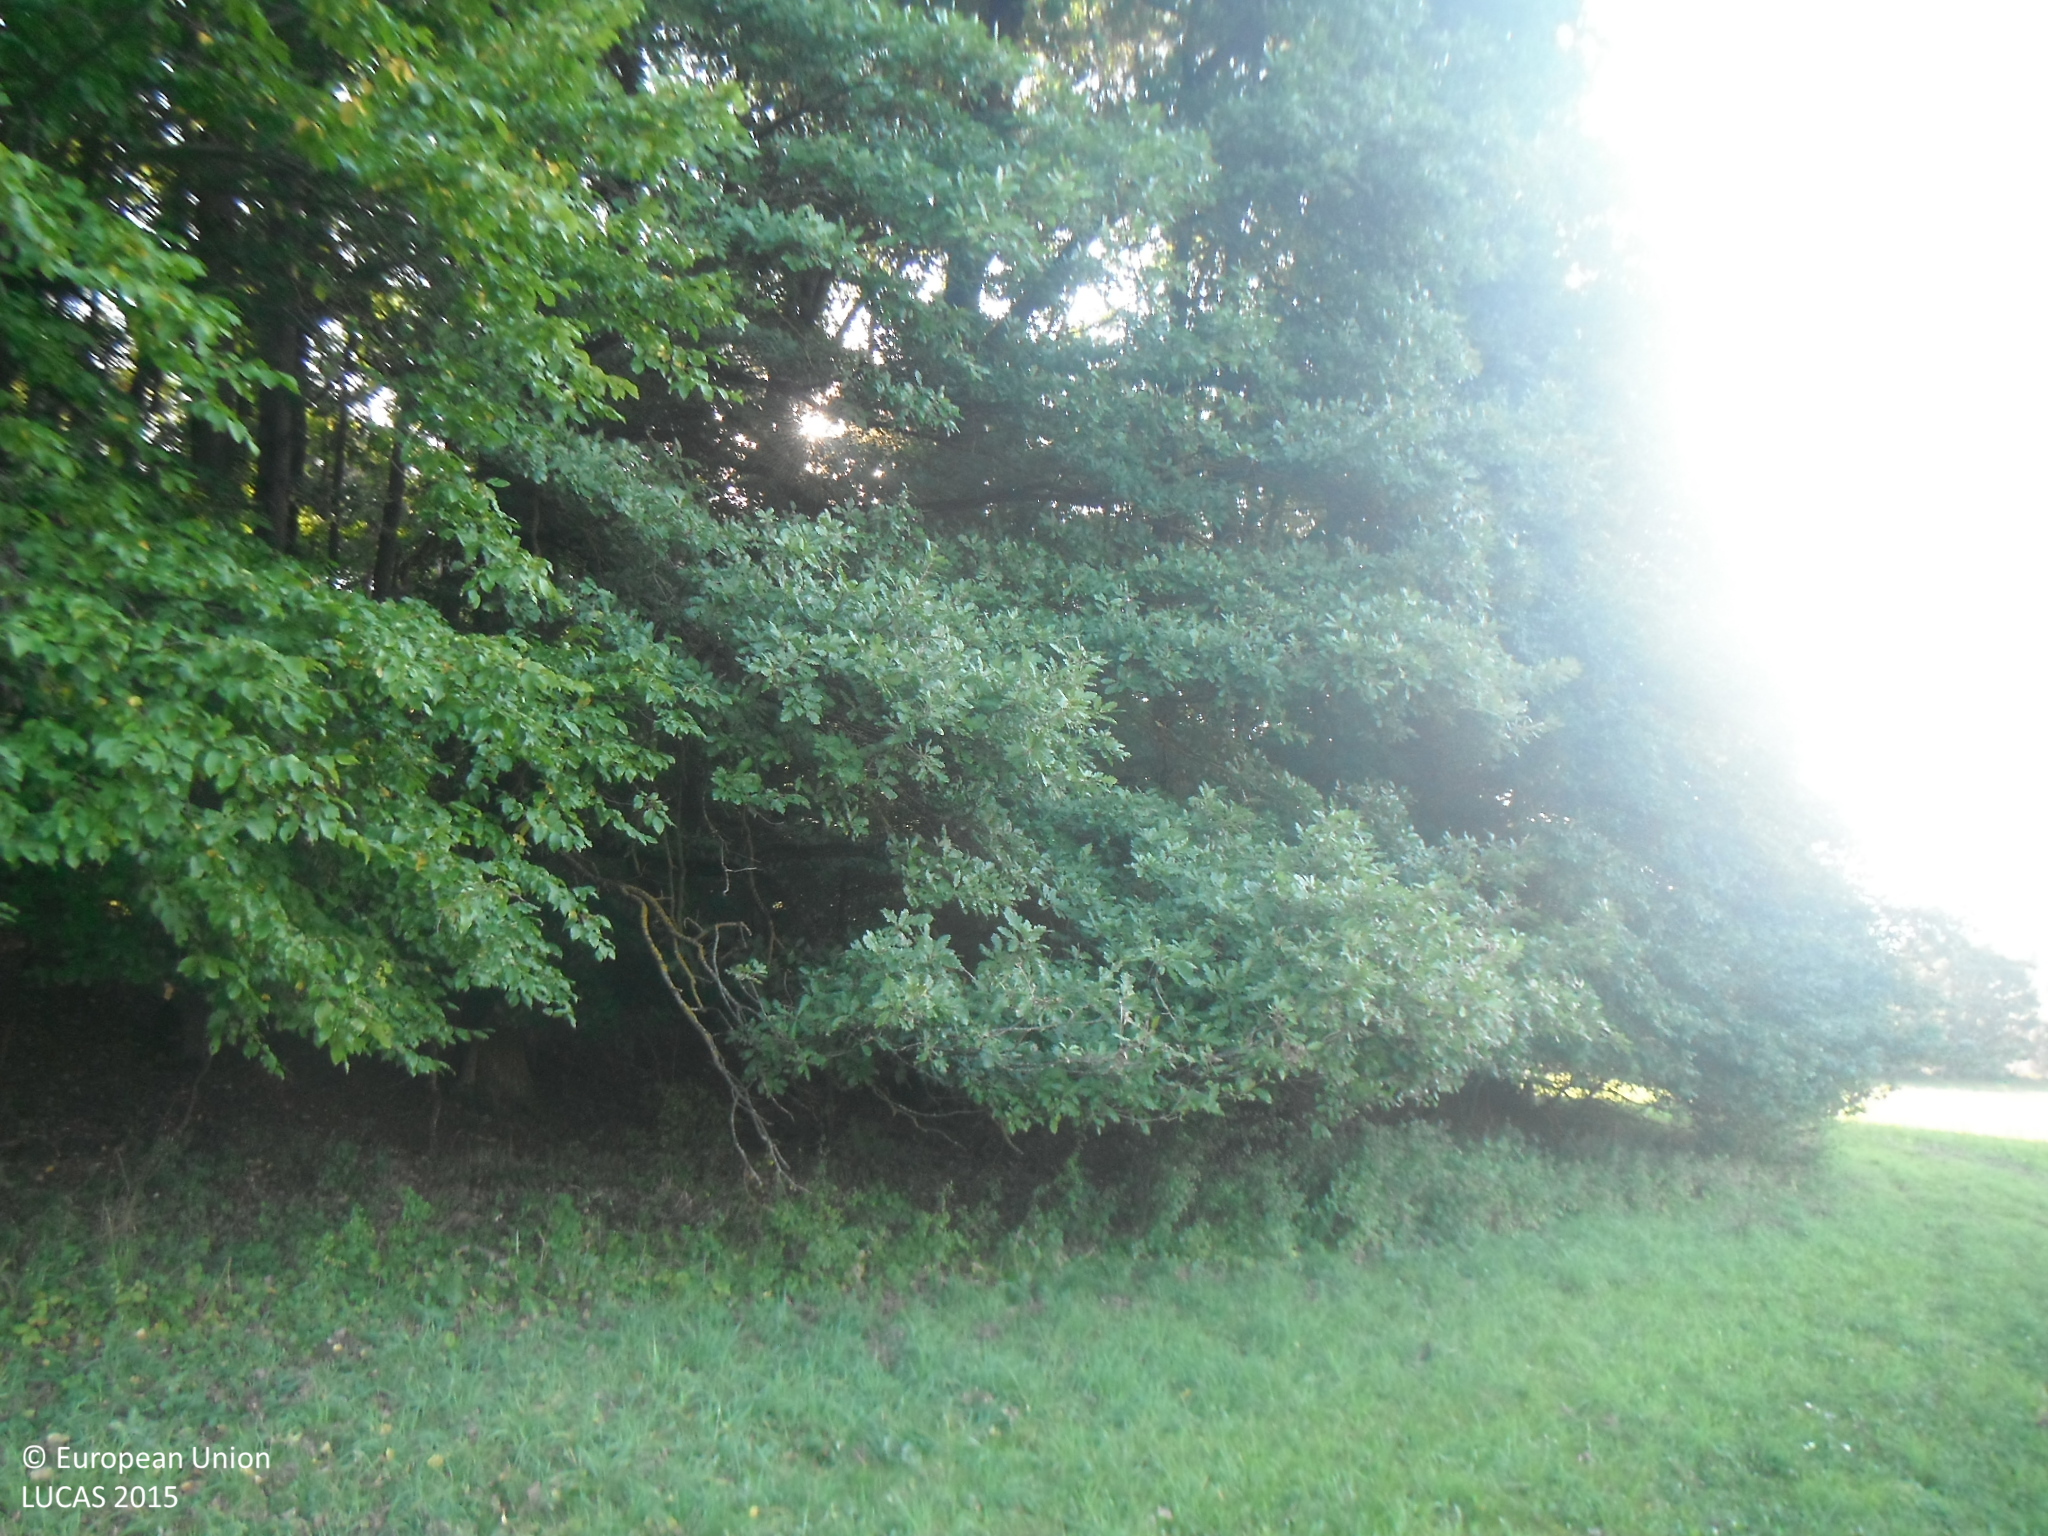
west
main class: Grassland
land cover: Grassland without tree/shrub cover
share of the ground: > 75 %
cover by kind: herbaceous plants 100 %
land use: Agriculture (excluding fallow land and kitchen gardens)
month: August
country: SK
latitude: 48.9826
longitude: 18.2280
